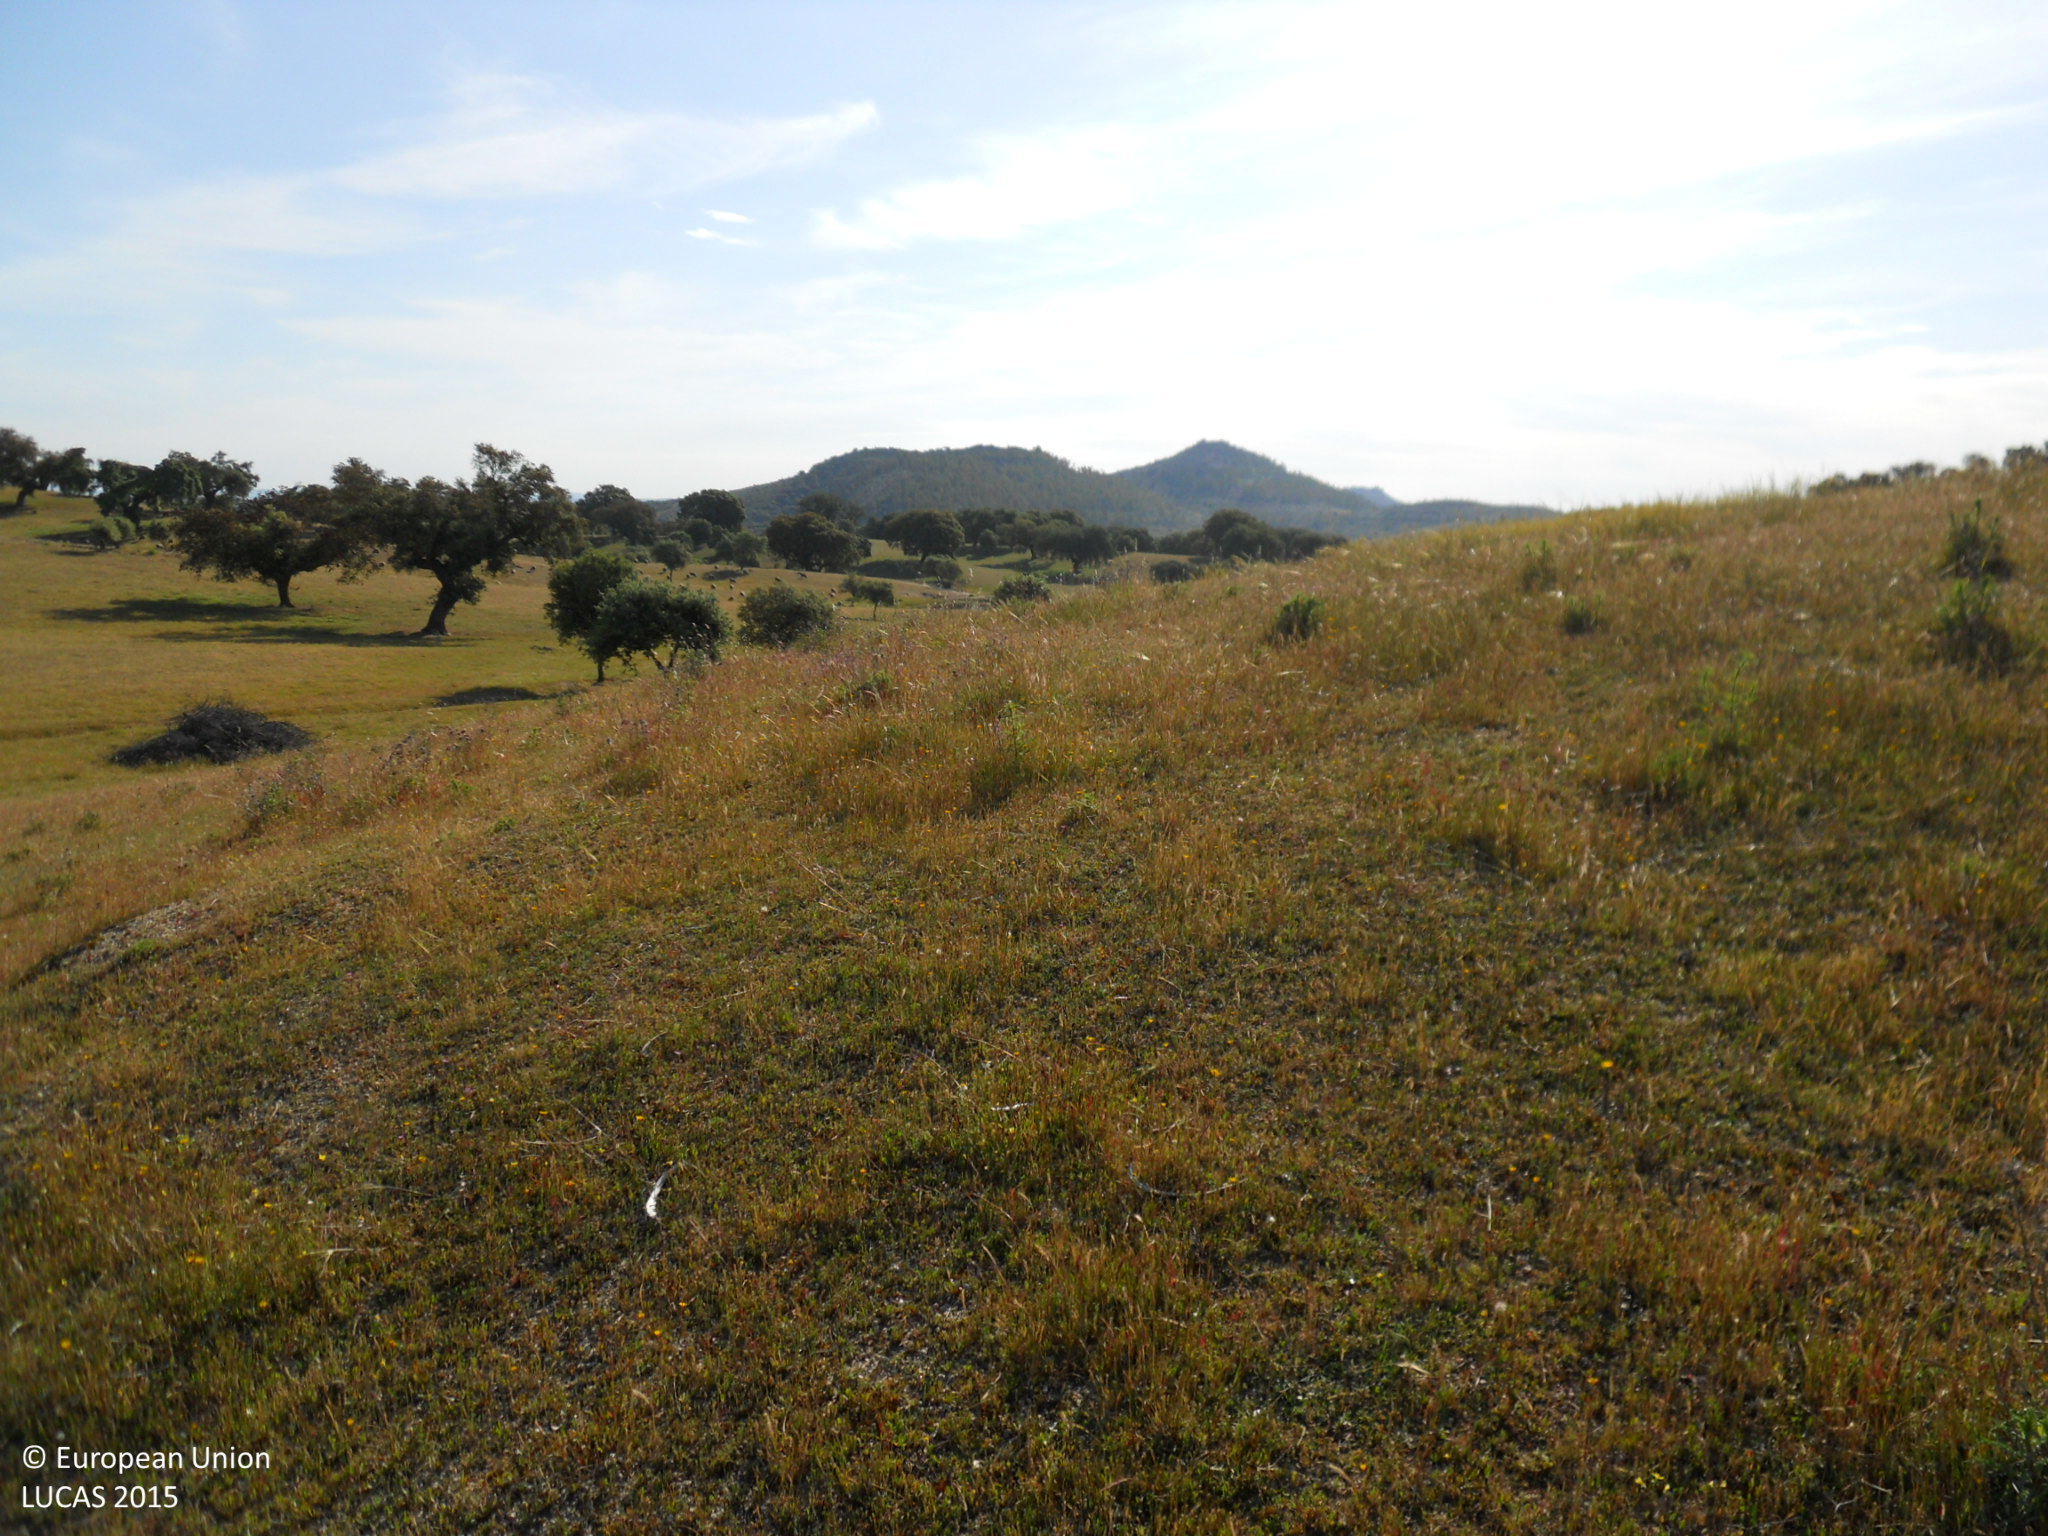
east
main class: Grassland
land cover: Grassland without tree/shrub cover
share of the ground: > 75 %
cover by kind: herbaceous plants 95 %, shrubs 5 %
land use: Agriculture (excluding fallow land and kitchen gardens)
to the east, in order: Grassland without tree/shrub cover; Tracks; Grassland without tree/shrub cover
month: April
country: ES
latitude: 39.2265
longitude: -6.9296
